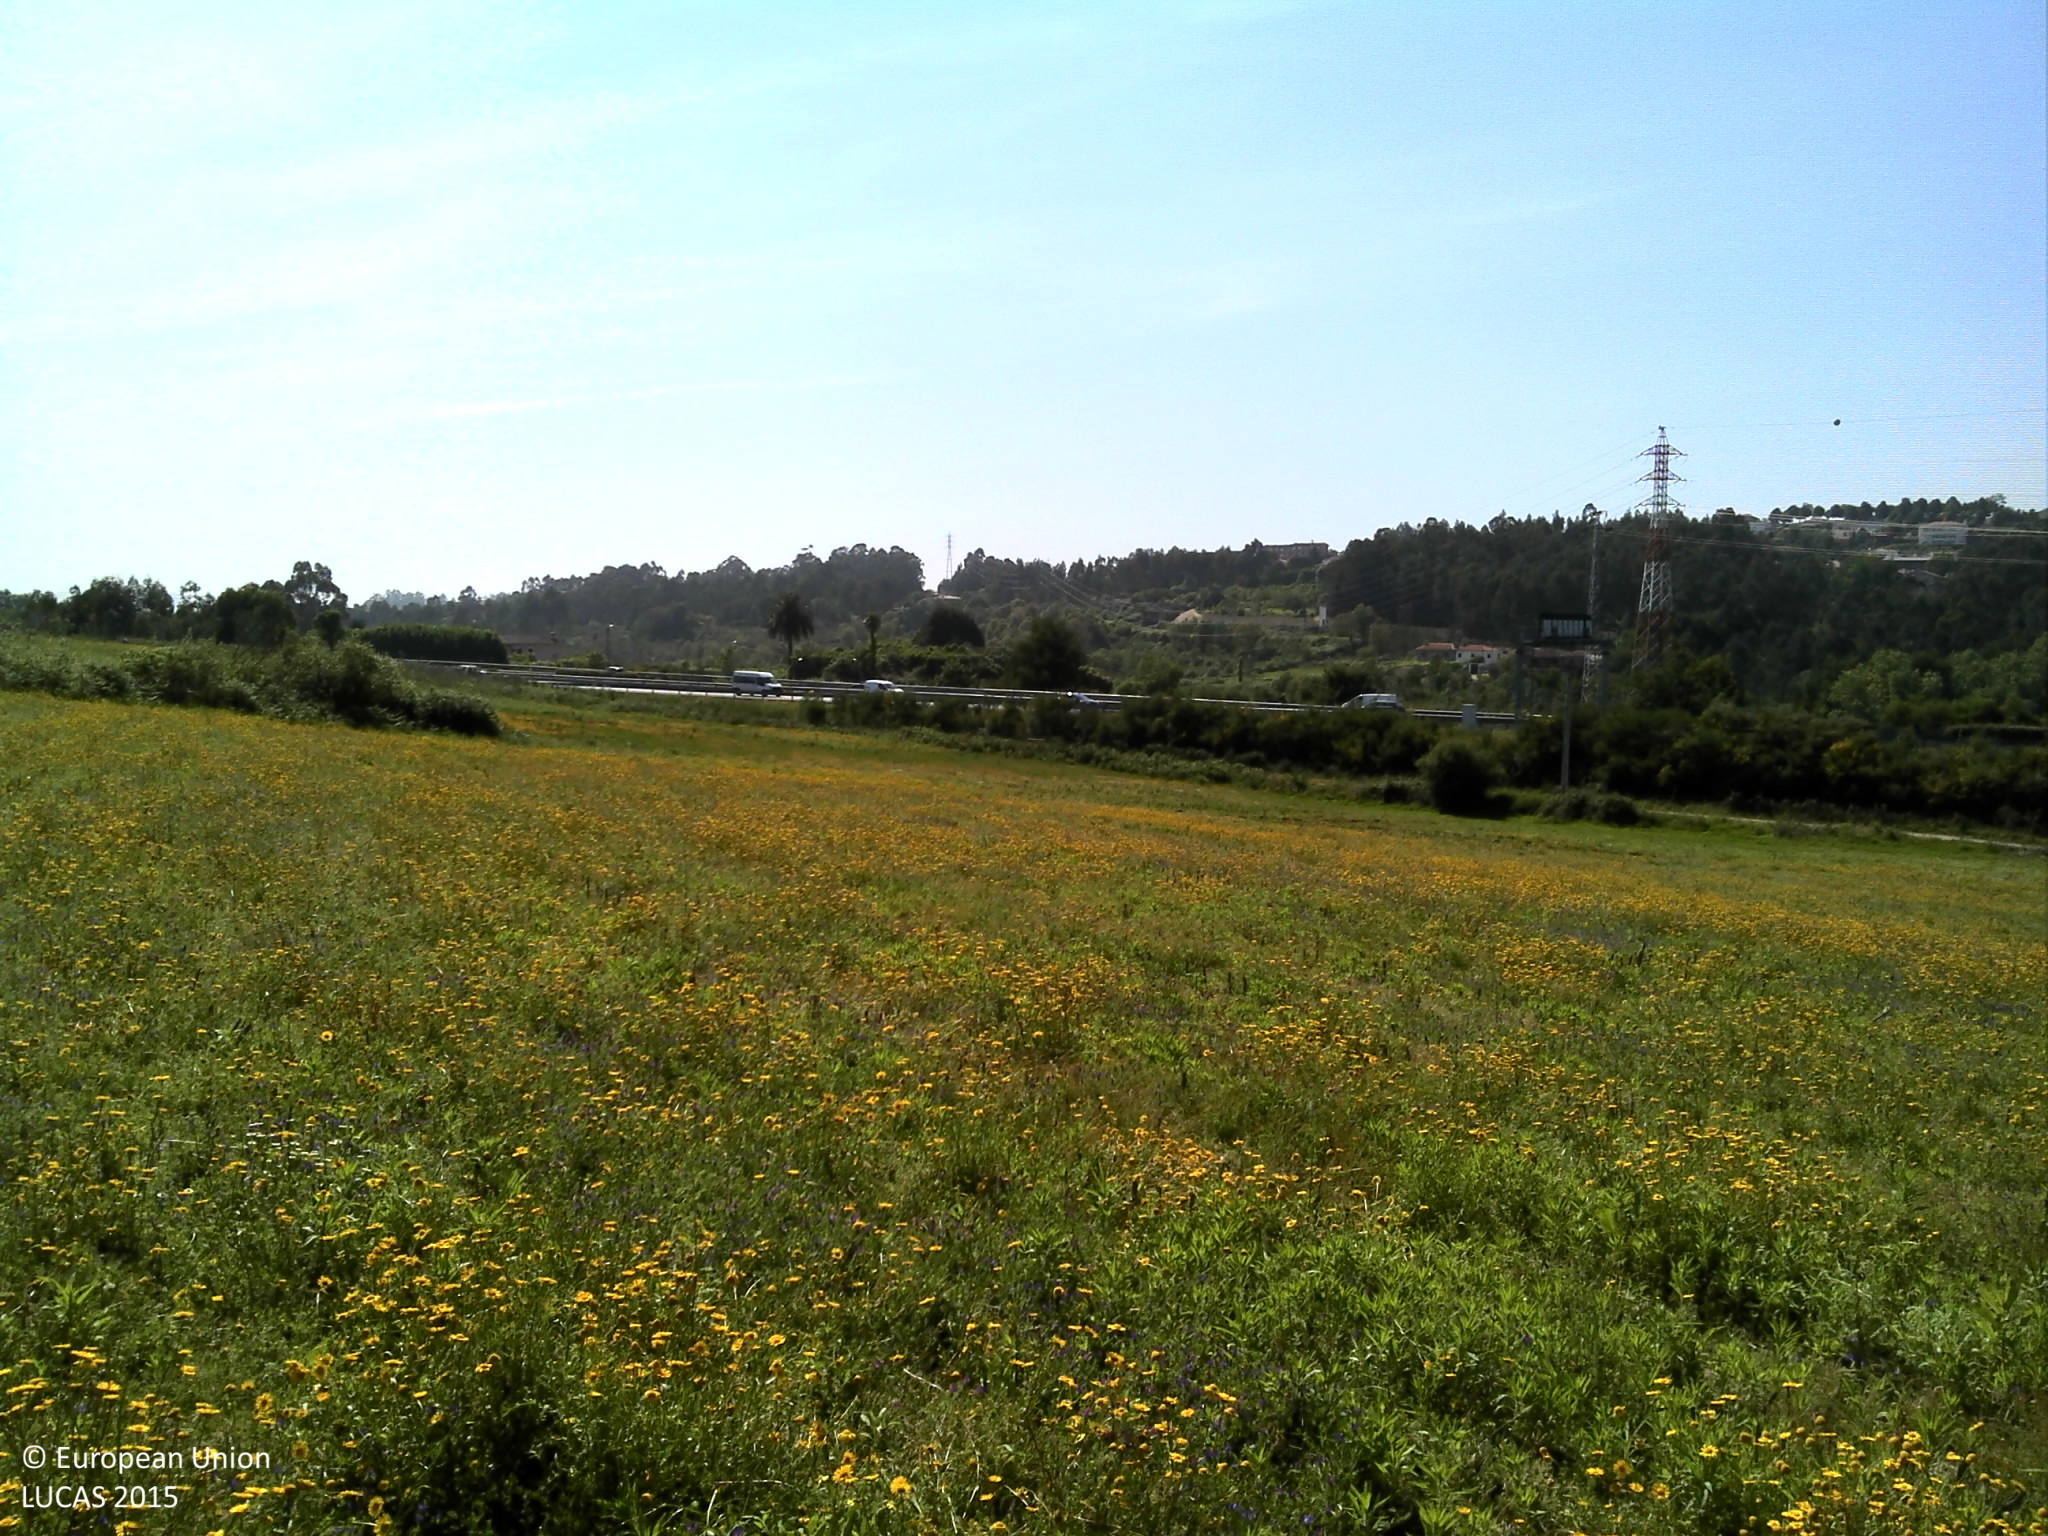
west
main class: Grassland
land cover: Grassland without tree/shrub cover
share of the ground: 50 - 75 %
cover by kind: herbaceous plants 95 %, unconsolidated bare surface 5 %
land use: Agriculture (excluding fallow land and kitchen gardens)
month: May
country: PT
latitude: 41.3570
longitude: -8.5011
